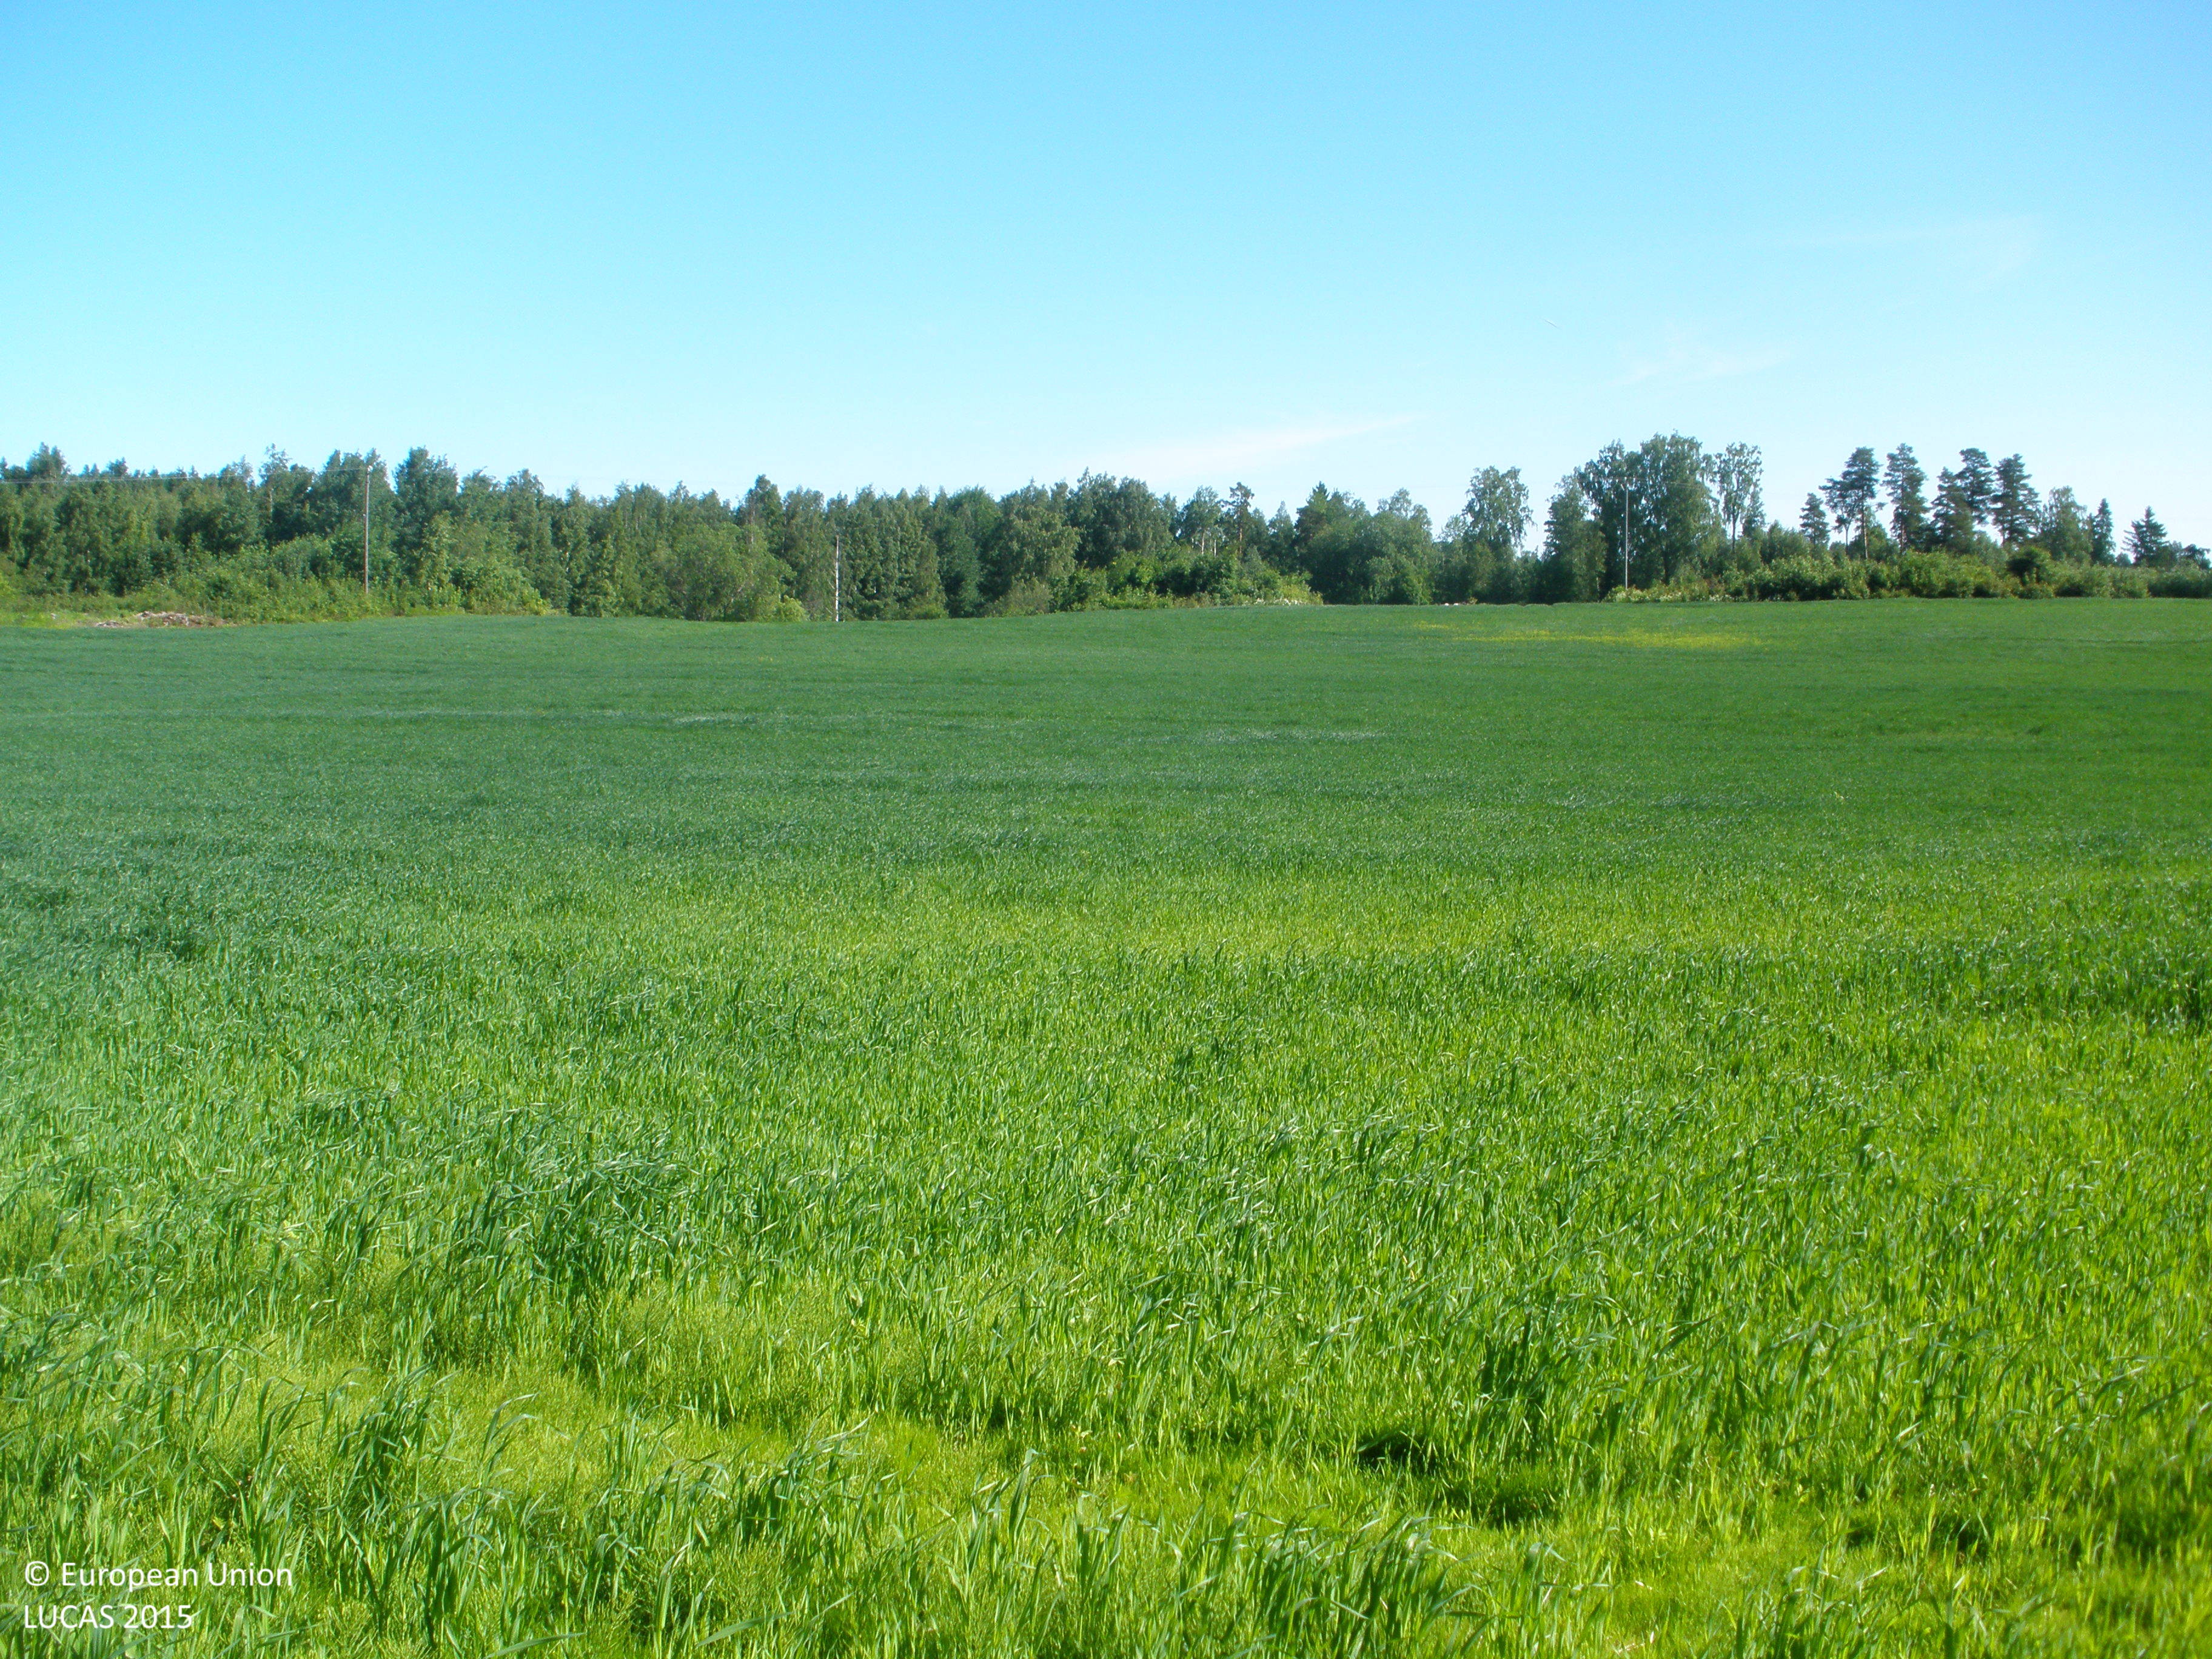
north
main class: Woodland
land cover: Broadleaved woodland
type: non-riverine alder, birch or aspen forest
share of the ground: > 75 %
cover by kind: broadleaved forest trees 85 %, shrubs 10 %, herbaceous plants 5 %
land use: Forestry
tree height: > 5 m
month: July
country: FI
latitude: 61.2443
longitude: 23.9344
